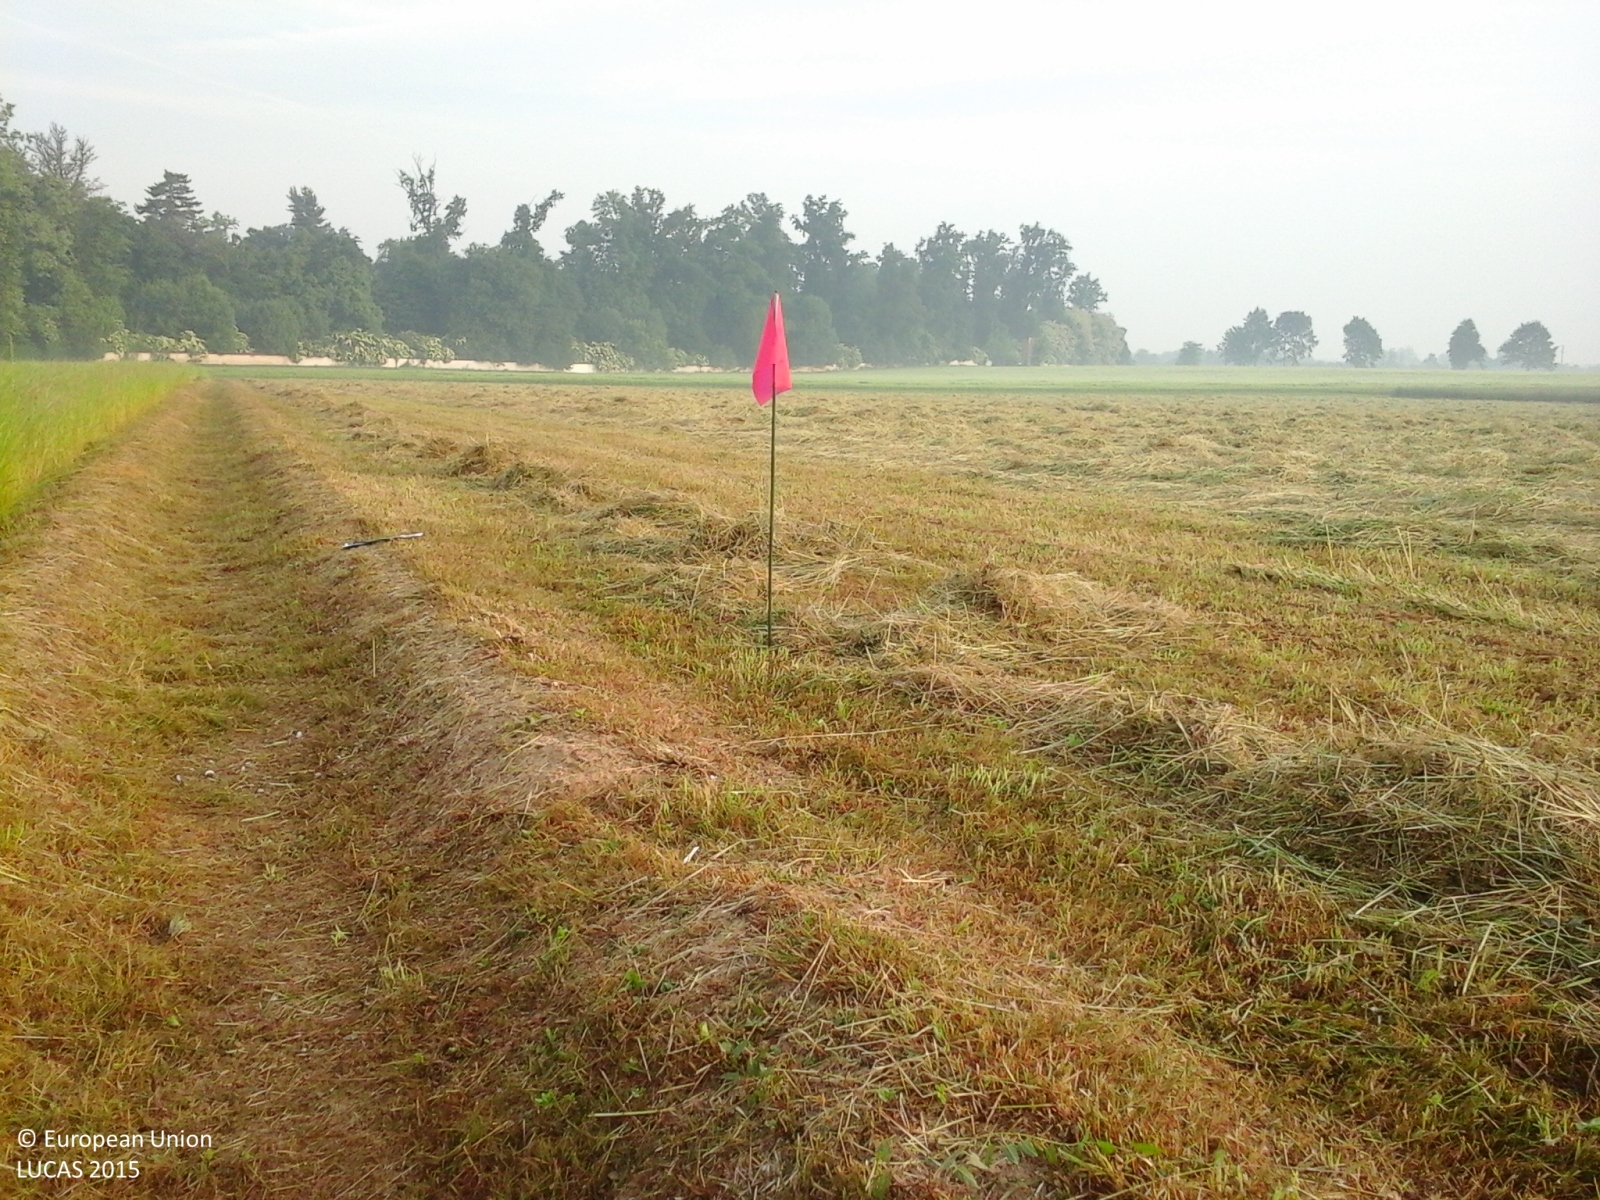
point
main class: Cropland
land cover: Temporary grasslands
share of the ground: > 75 %
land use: Agriculture (excluding fallow land and kitchen gardens)
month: May
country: IT
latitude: 44.9031
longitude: 7.7372
